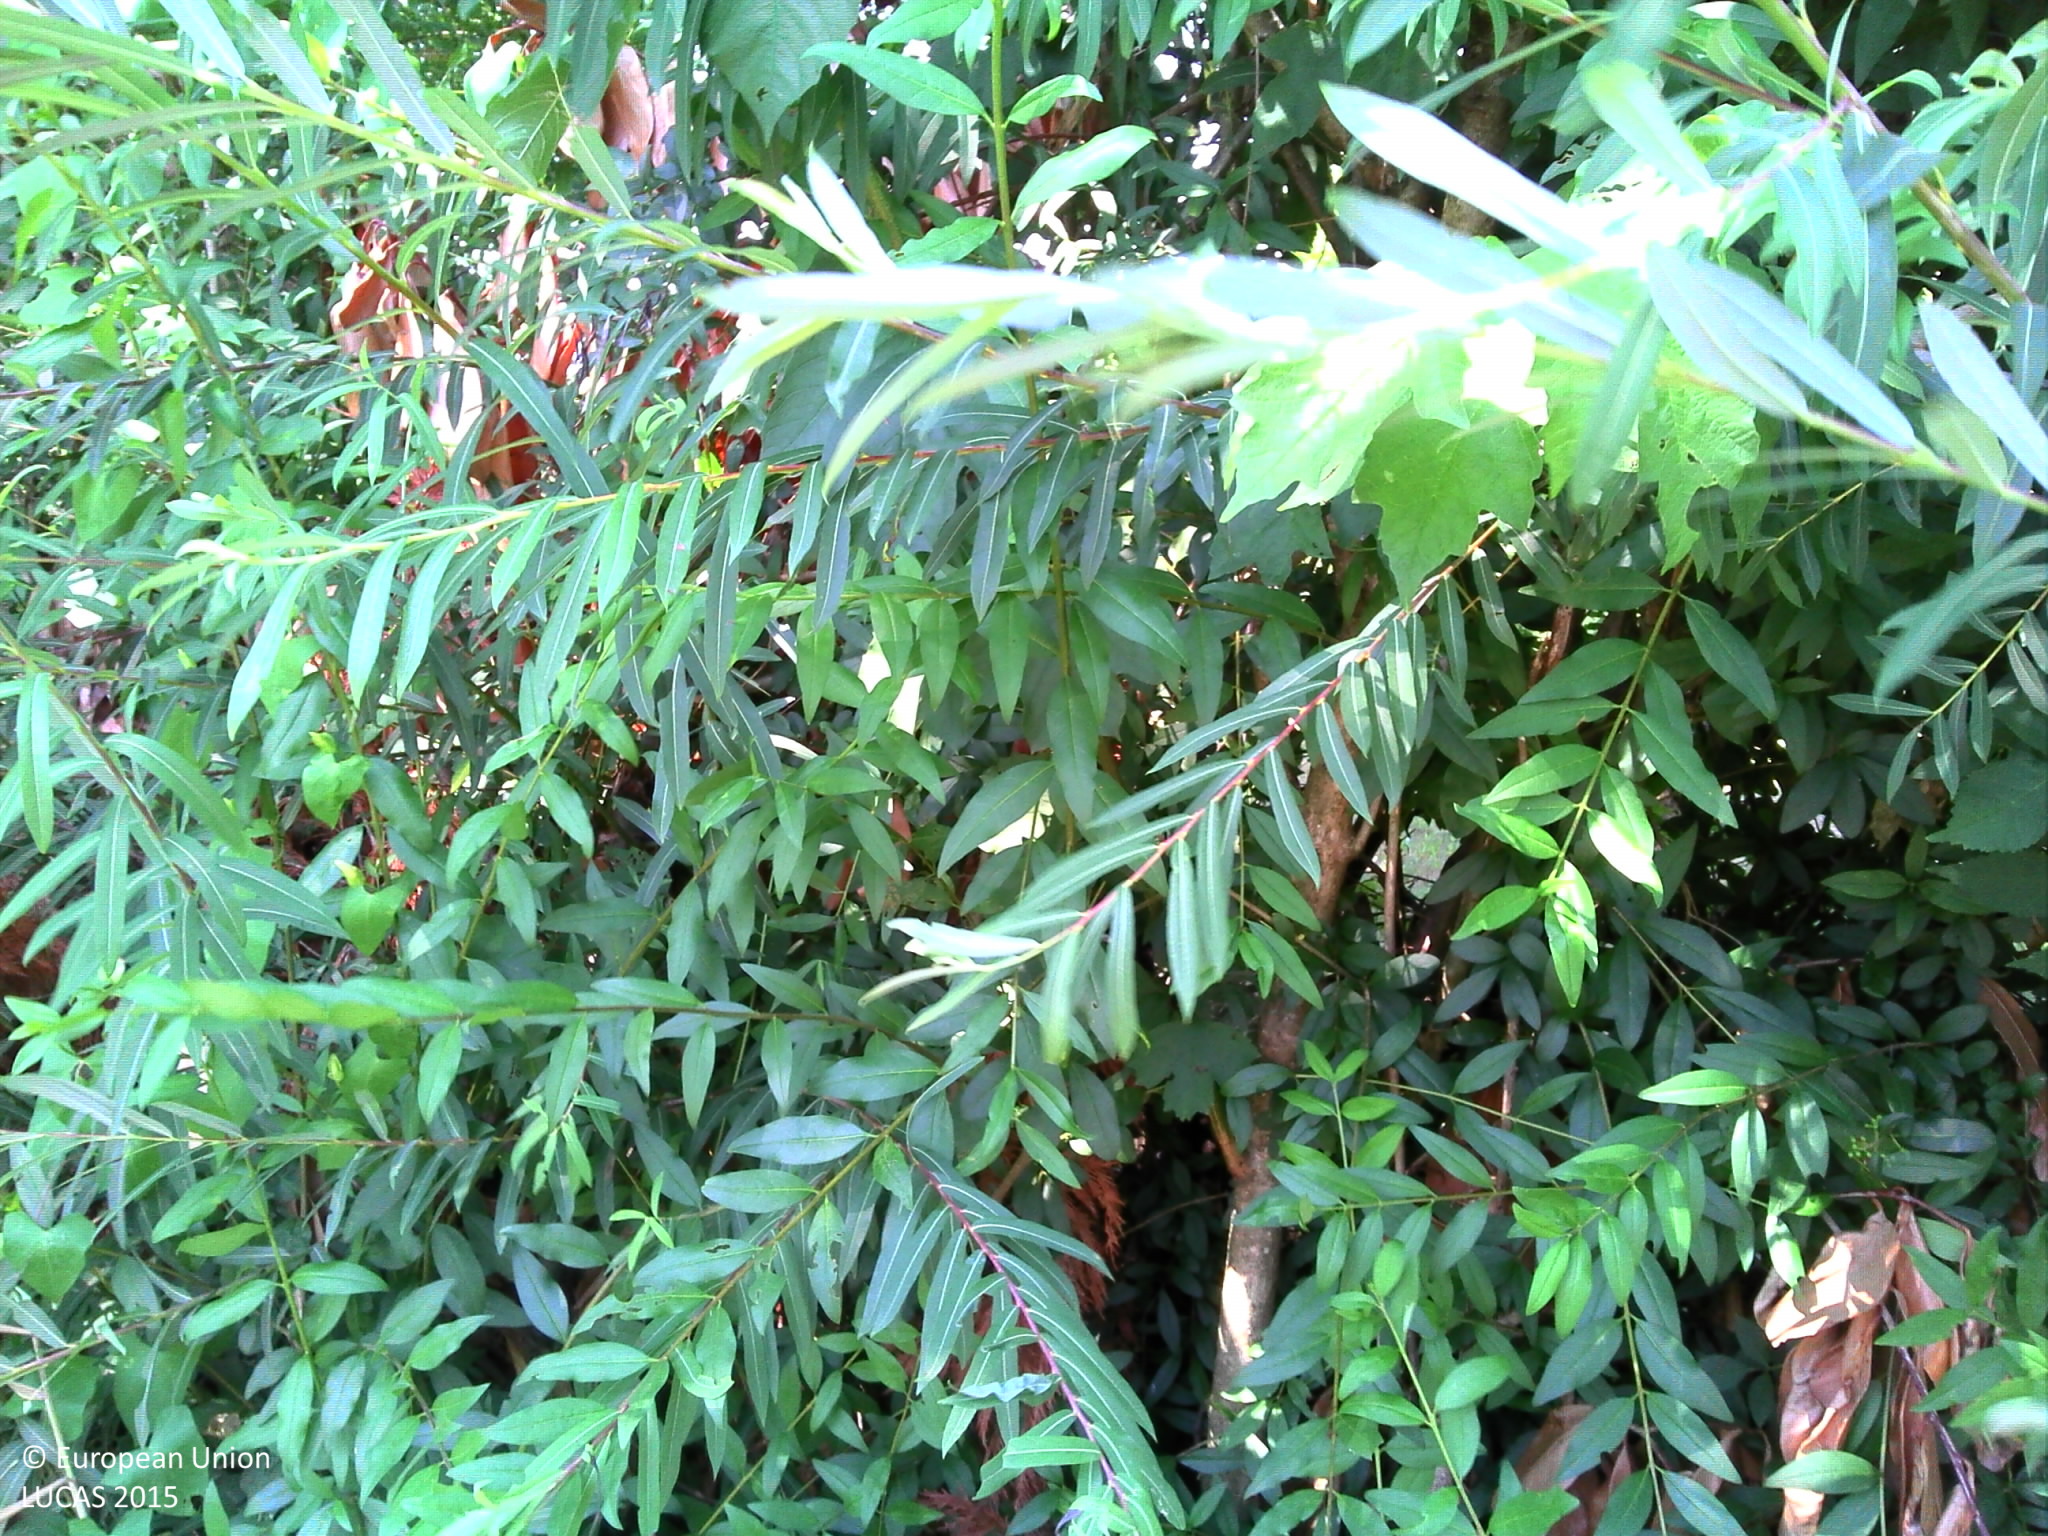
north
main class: Woodland
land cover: Broadleaved woodland
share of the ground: > 75 %
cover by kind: broadleaved forest trees 90 %, herbaceous plants 10 %
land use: Semi-natural and natural areas not in use
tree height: > 5 m
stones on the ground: < 10 %
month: July
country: FR
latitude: 45.6388
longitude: 5.3986
